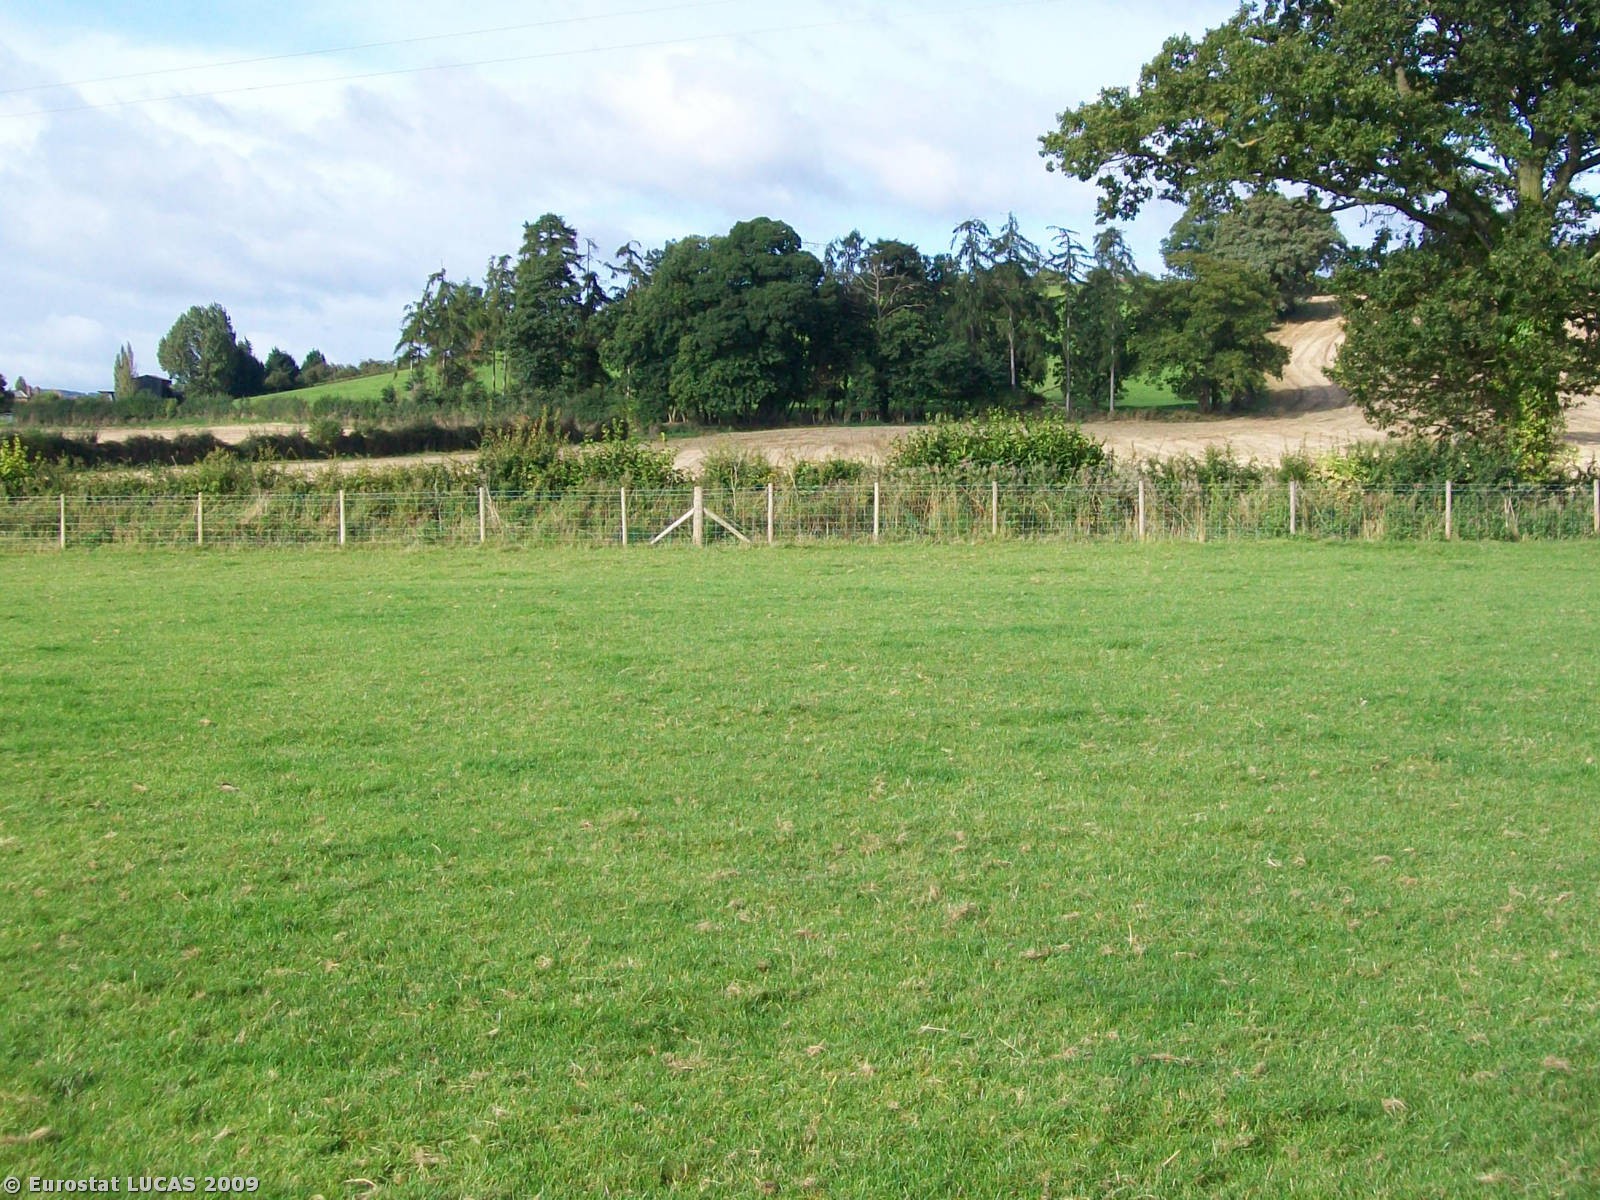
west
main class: Grassland
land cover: Grassland without tree/shrub cover
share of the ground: > 75 %
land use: Agriculture (excluding fallow land and kitchen gardens)
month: September
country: GB
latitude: 52.0793
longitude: -2.4837
